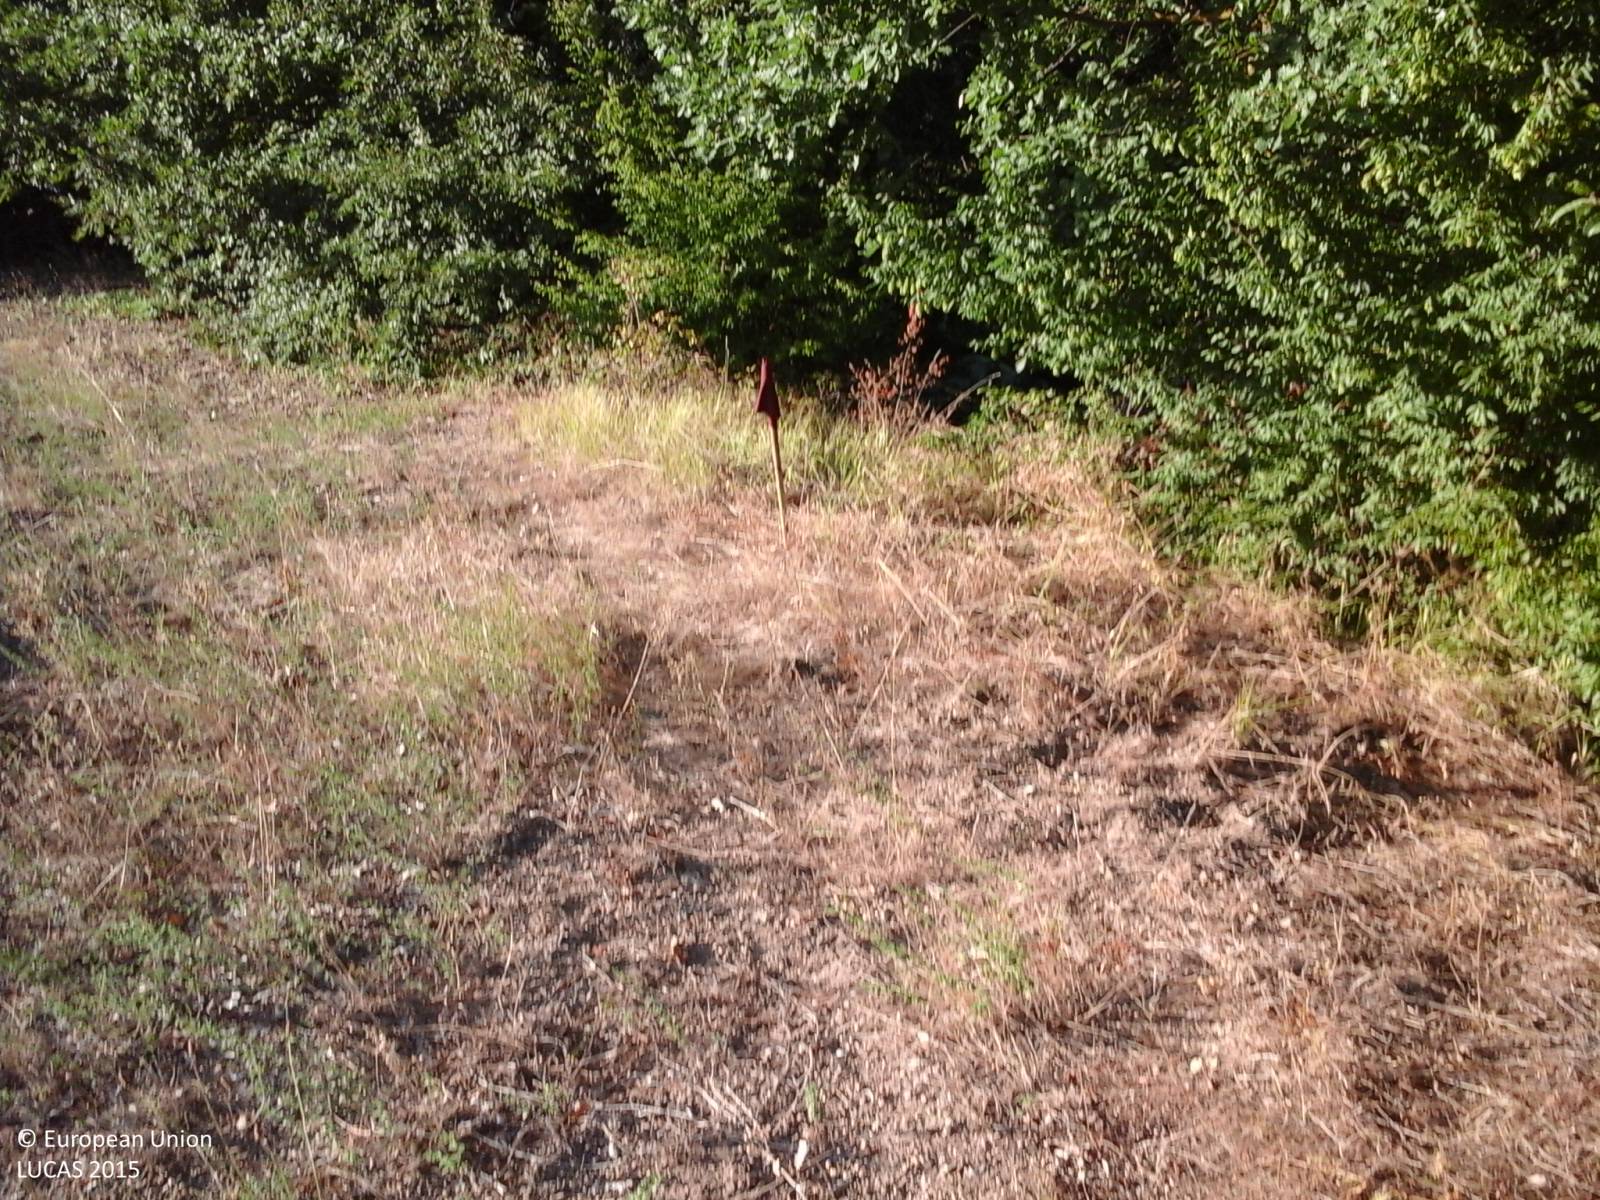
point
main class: Grassland
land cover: Grassland without tree/shrub cover
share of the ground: > 75 %
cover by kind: herbaceous plants 100 %
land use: Agriculture (excluding fallow land and kitchen gardens)
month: July
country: IT
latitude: 42.1877
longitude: 12.5701
